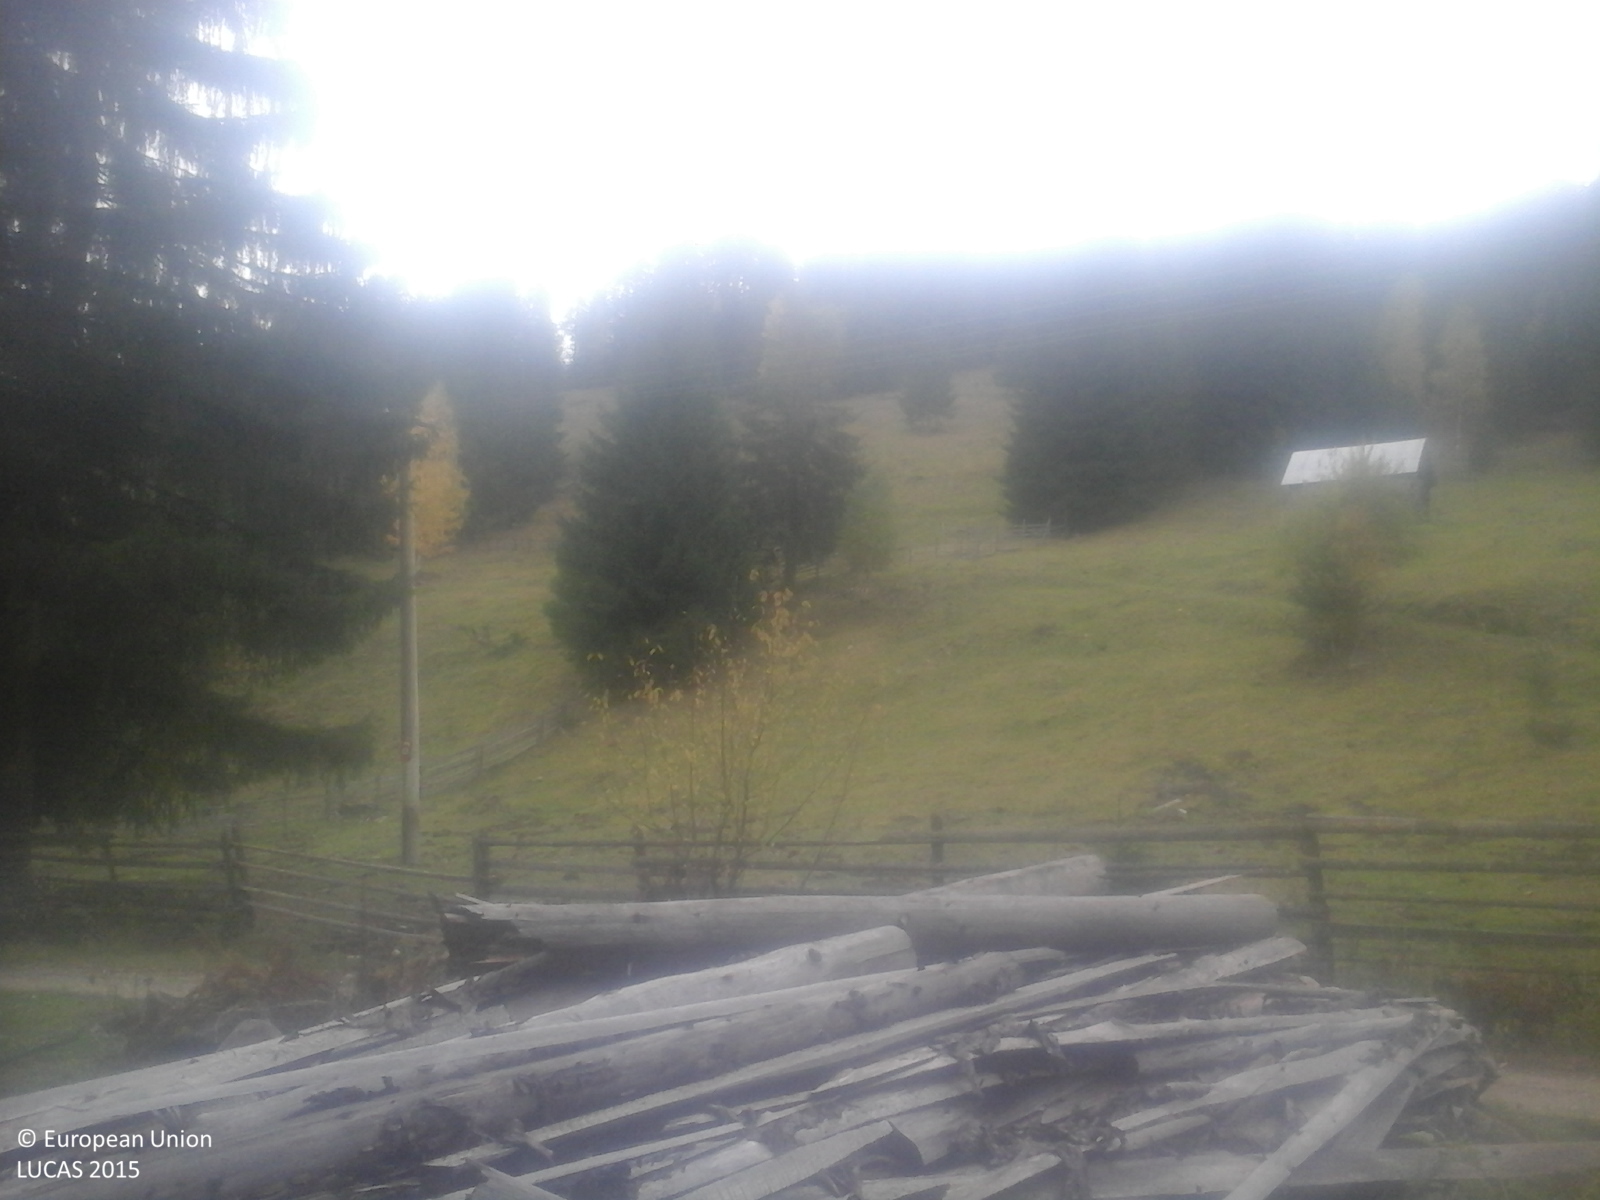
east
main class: Woodland
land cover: Spruce dominated coniferous woodland
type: alpine coniferous forest
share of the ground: 50 - 75 %
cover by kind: coniferous forest trees 60 %, herbaceous plants 40 %
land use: Forestry
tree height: > 5 m
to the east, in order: Spruce dominated coniferous woodland; Grassland without tree/shrub cover; Fences; Grassland without tree/shrub cover; Artificial constructions in urban areas; Grassland without tree/shrub cover; Fences; Grassland without tree/shrub cover; Fences; Rivers and streams; Abandoned hedges; Shruby margins; Tracks; Shruby margins; Fences; Electric lines; Grassland with sparse tree/shrub cover; Fences; Grassland with sparse tree/shrub cover
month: October
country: RO
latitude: 47.2082
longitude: 25.3865
